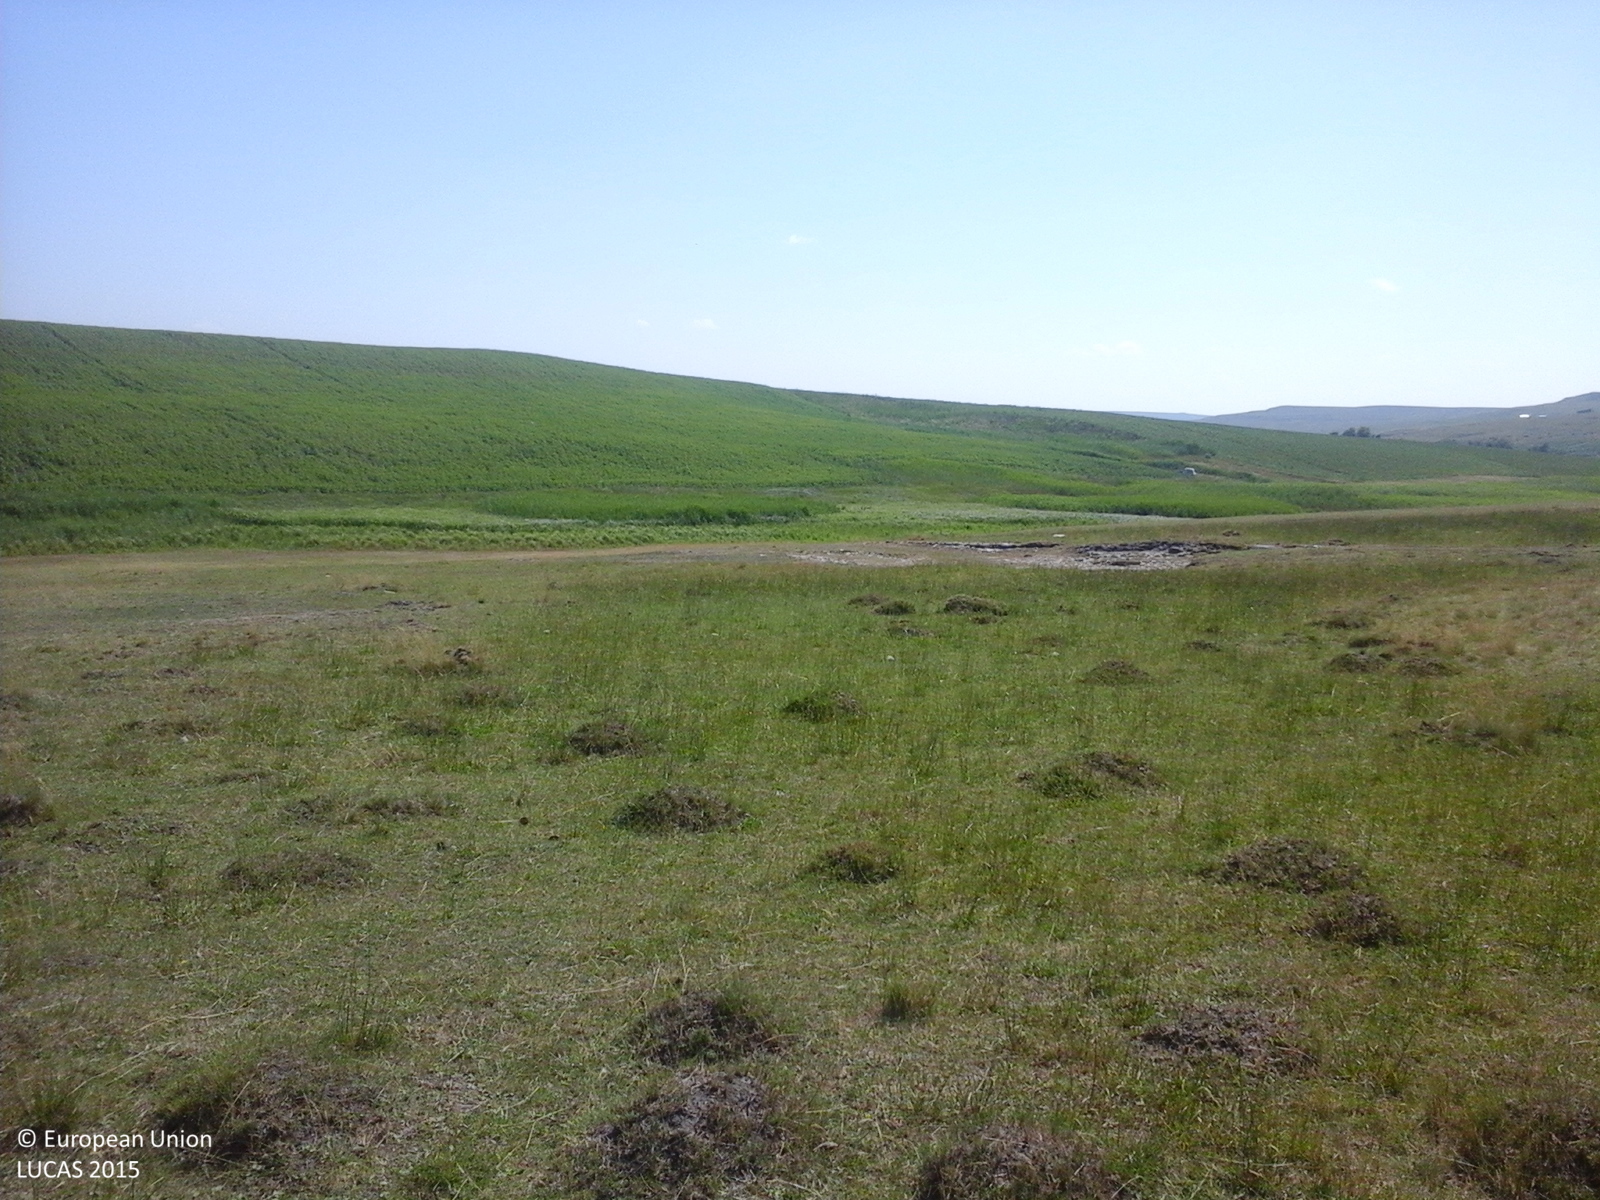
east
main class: Grassland
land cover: Grassland without tree/shrub cover
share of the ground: > 75 %
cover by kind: herbaceous plants 100 %
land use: Agriculture (excluding fallow land and kitchen gardens)
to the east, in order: Grassland without tree/shrub cover; Inland marshes; Ditches and canals; Inland marshes; Spontaneously vegetated surfaces; Sunflower
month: June
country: RO
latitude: 47.7153
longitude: 27.1304
